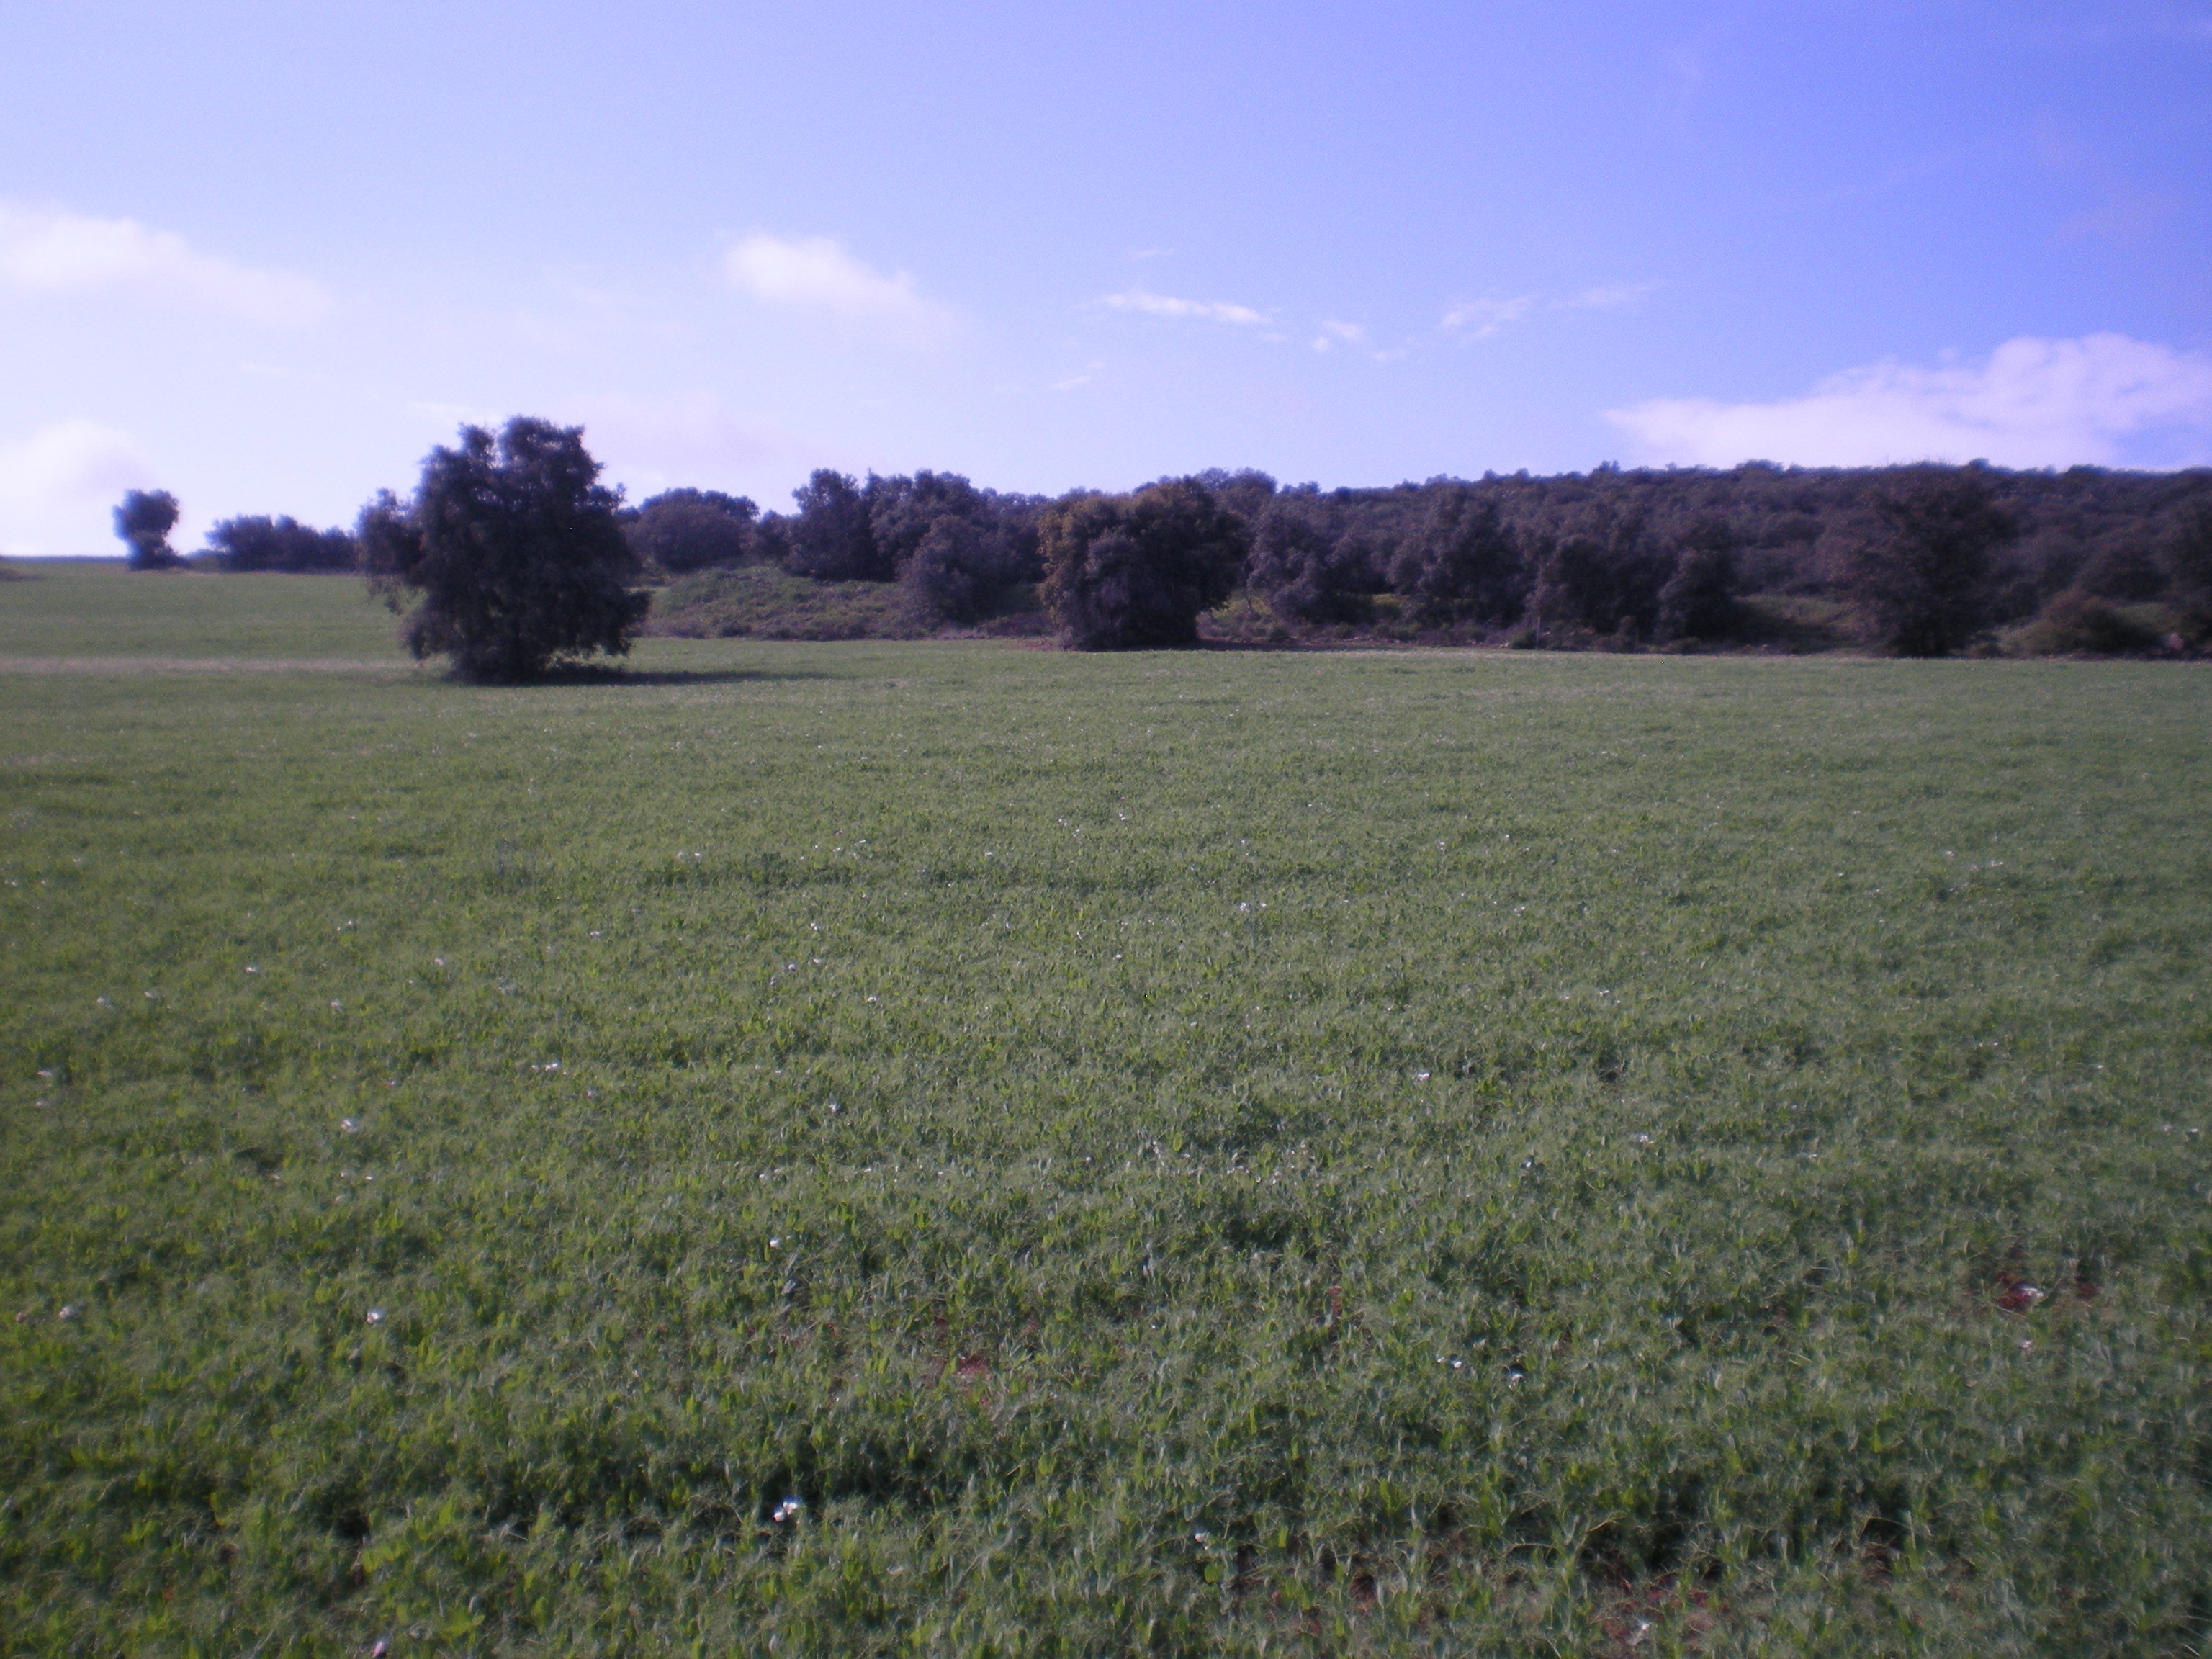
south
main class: Cropland
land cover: Dry pulses
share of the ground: > 75 %
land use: Agriculture (excluding fallow land and kitchen gardens)
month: April
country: ES
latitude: 38.5849
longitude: -3.4521
